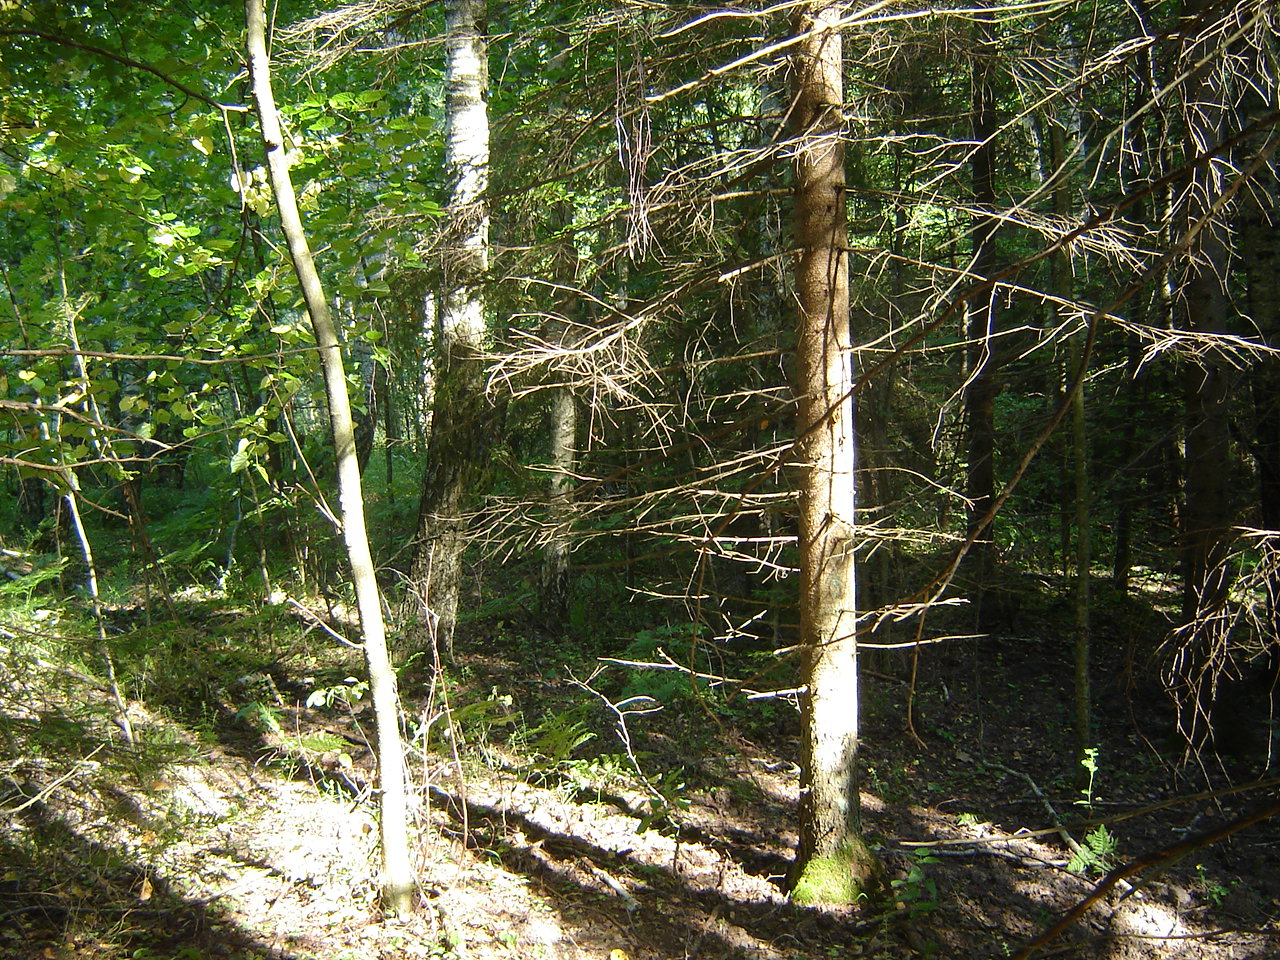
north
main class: Woodland
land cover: Other mixed woodland
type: hemiboreal forest and nemoral coniferous forest and mixed broadleaved-coniferous forest
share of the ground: > 75 %
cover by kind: coniferous forest trees 50 %, broadleaved forest trees 40 %, herbaceous plants 5 %, unconsolidated bare surface 5 %
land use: Forestry
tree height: > 5 m
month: August
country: LT
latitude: 55.0840
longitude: 25.1080
